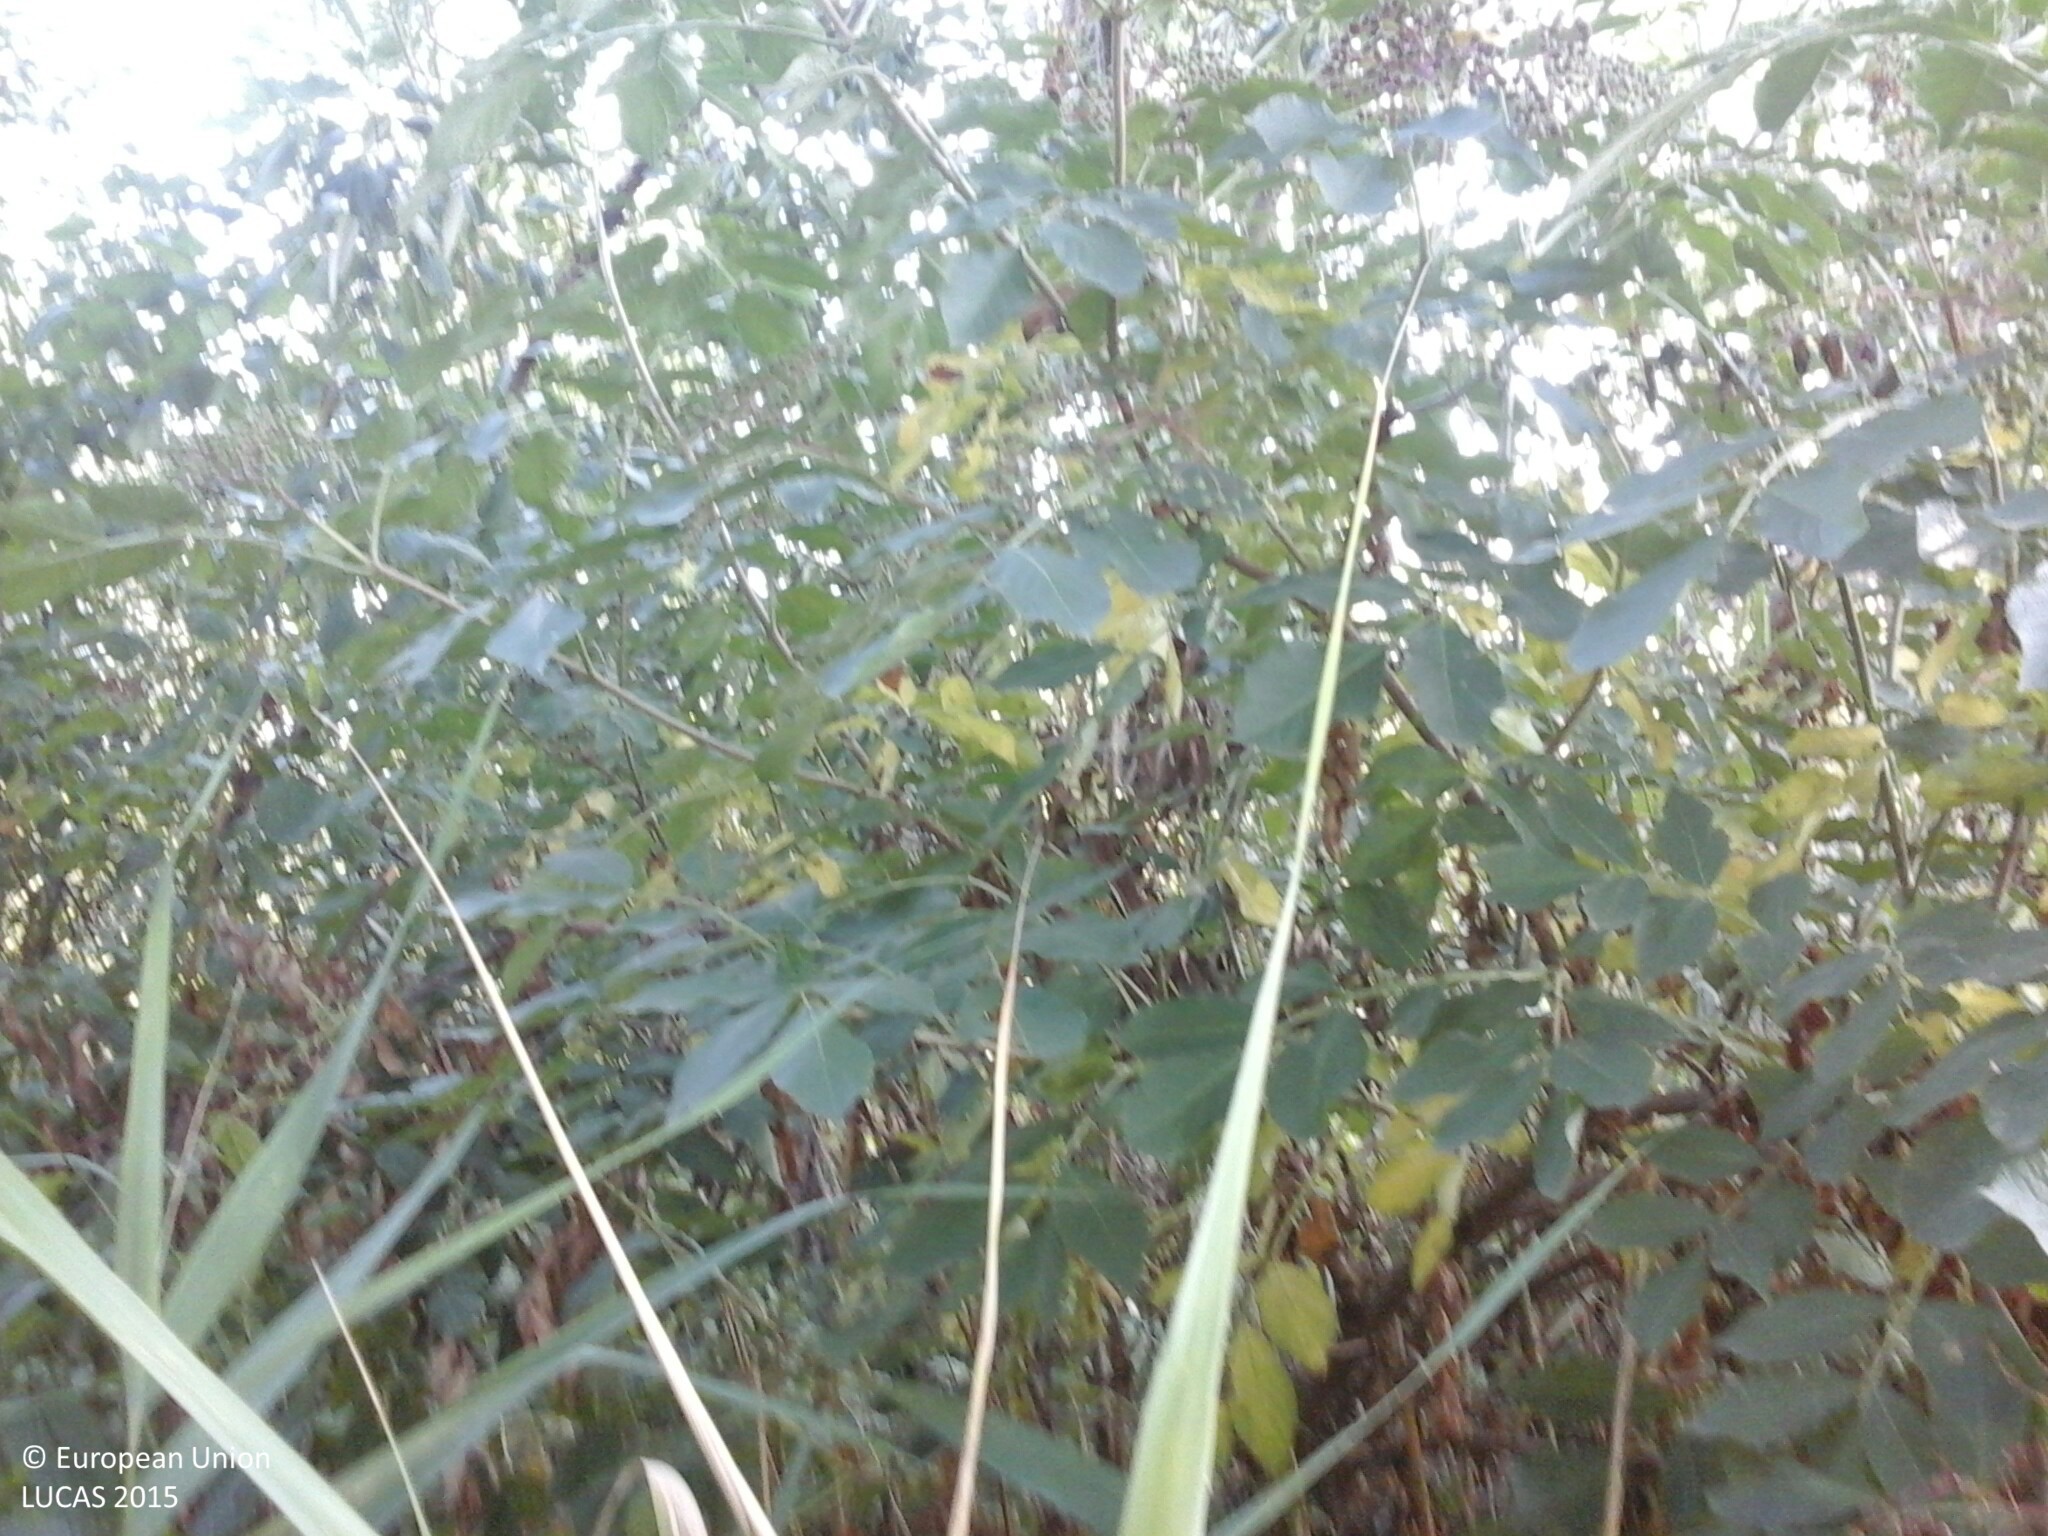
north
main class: Woodland
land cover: Broadleaved woodland
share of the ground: > 75 %
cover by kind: broadleaved forest trees 95 %, herbaceous plants 5 %
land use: Forestry
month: July
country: HU
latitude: 47.9729
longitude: 21.9328
